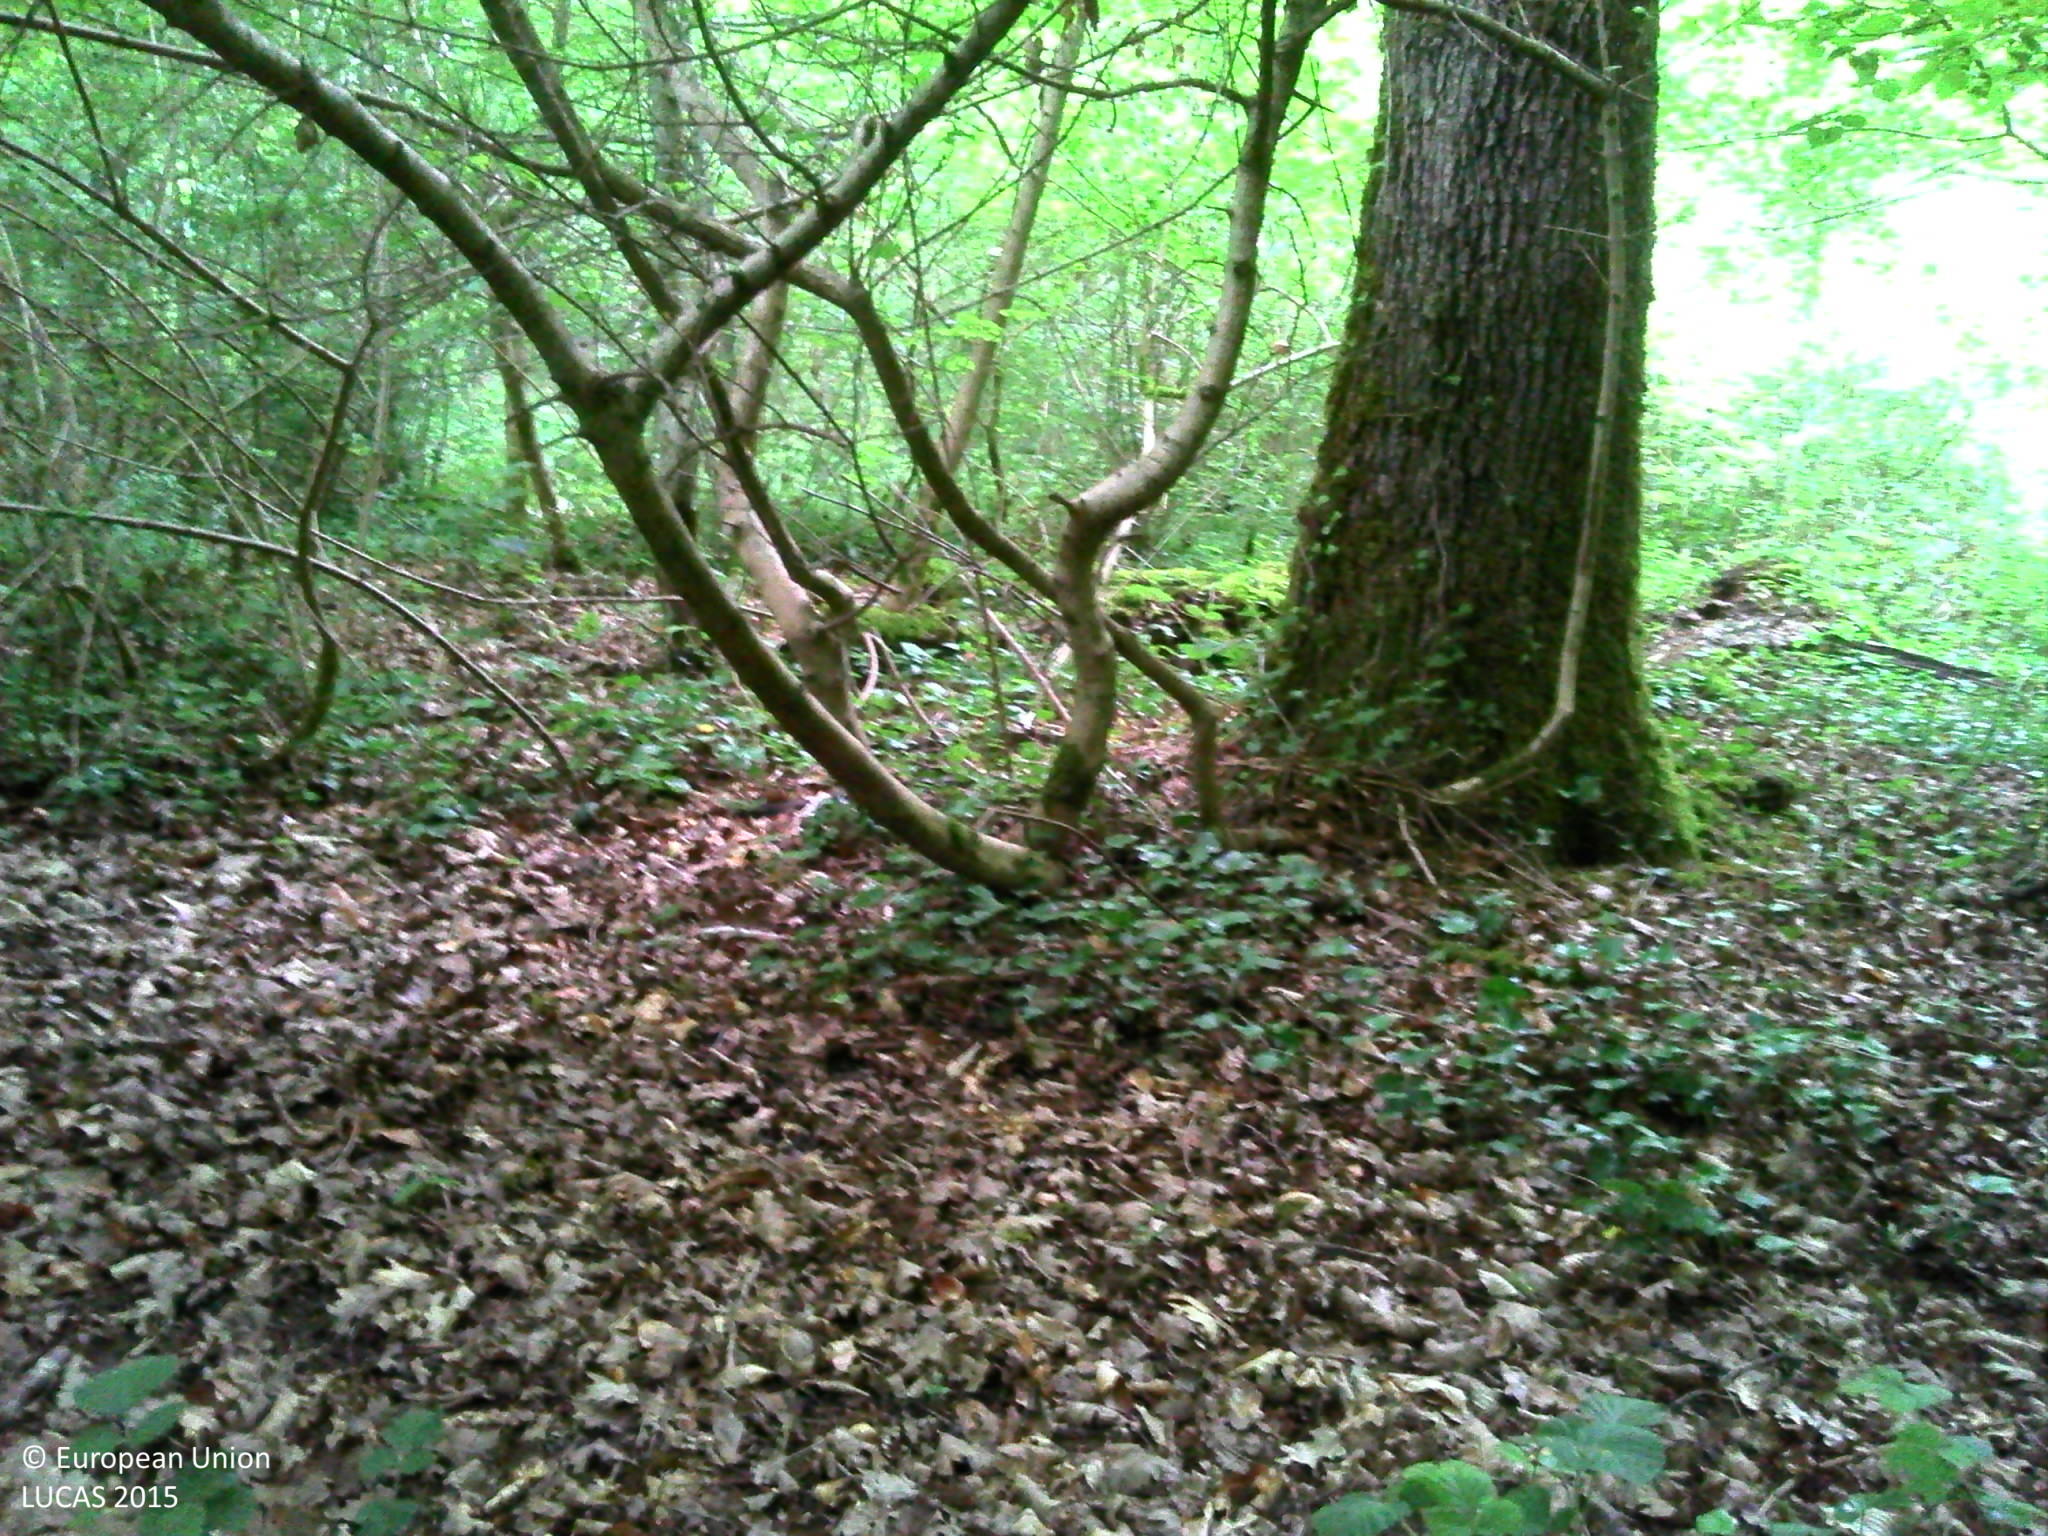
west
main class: Woodland
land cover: Broadleaved woodland
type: mesophytic deciduous forest
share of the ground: > 75 %
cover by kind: broadleaved forest trees 90 %, herbaceous plants 5 %, lichens and mosses 5 %
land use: Forestry
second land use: Amenities, museums, leisure
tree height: > 5 m
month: June
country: FR
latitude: 48.2835
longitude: 3.4852
